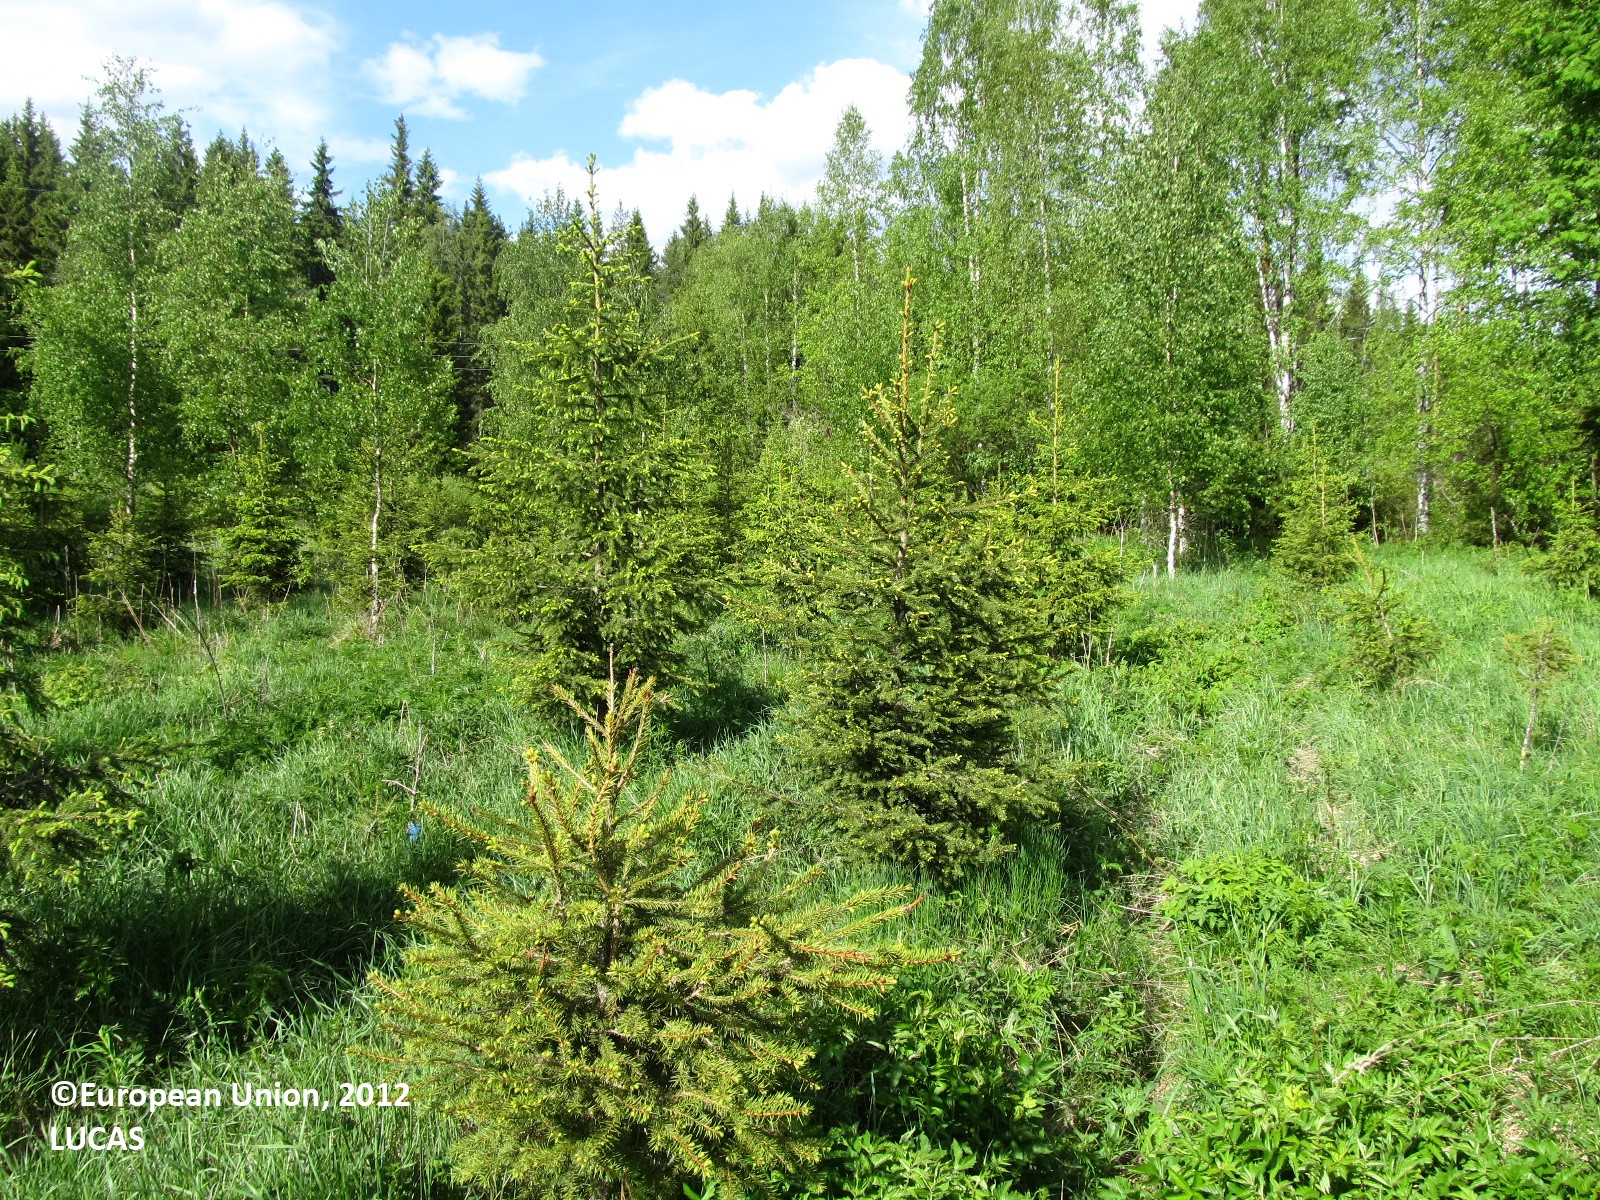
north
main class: Woodland
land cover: Spruce dominated coniferous woodland
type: boreal forest
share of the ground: 10 - 25 %
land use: Forestry
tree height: < 5 m
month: June
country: FI
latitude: 62.5294
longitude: 28.6469
